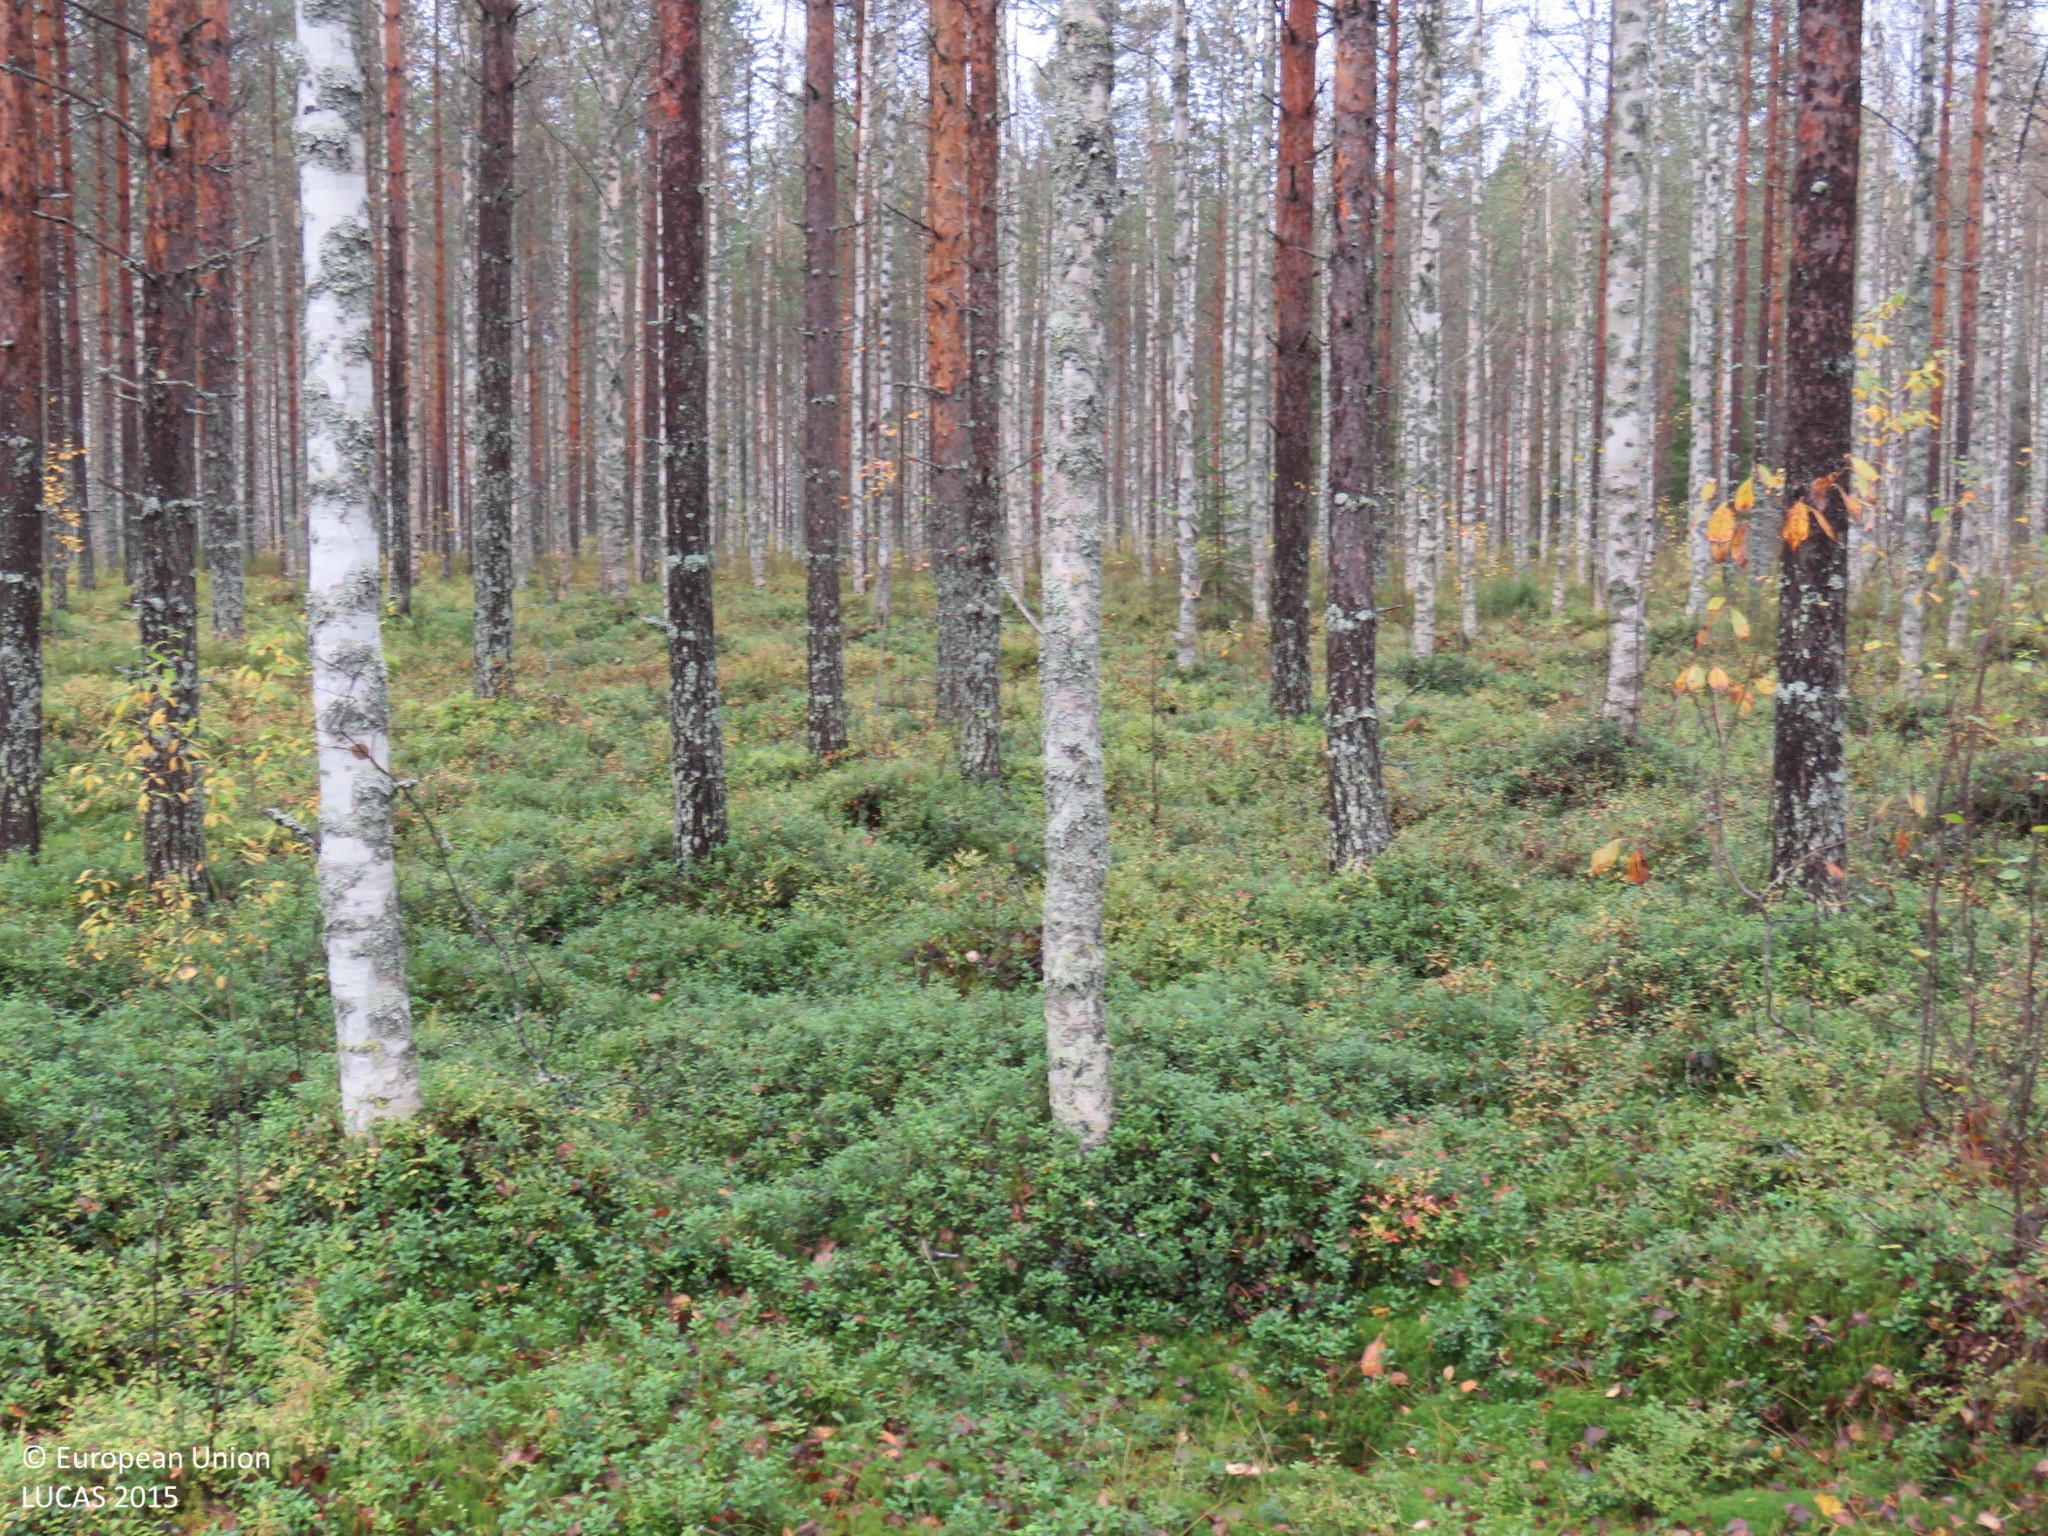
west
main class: Woodland
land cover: Pine dominated mixed woodland
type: boreal forest
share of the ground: 50 - 75 %
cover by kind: broadleaved forest trees 40 %, coniferous forest trees 30 %, shrubs 20 %, herbaceous plants 5 %, lichens and mosses 5 %
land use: Forestry
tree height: > 5 m
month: September
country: FI
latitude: 64.8787
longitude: 26.8604
